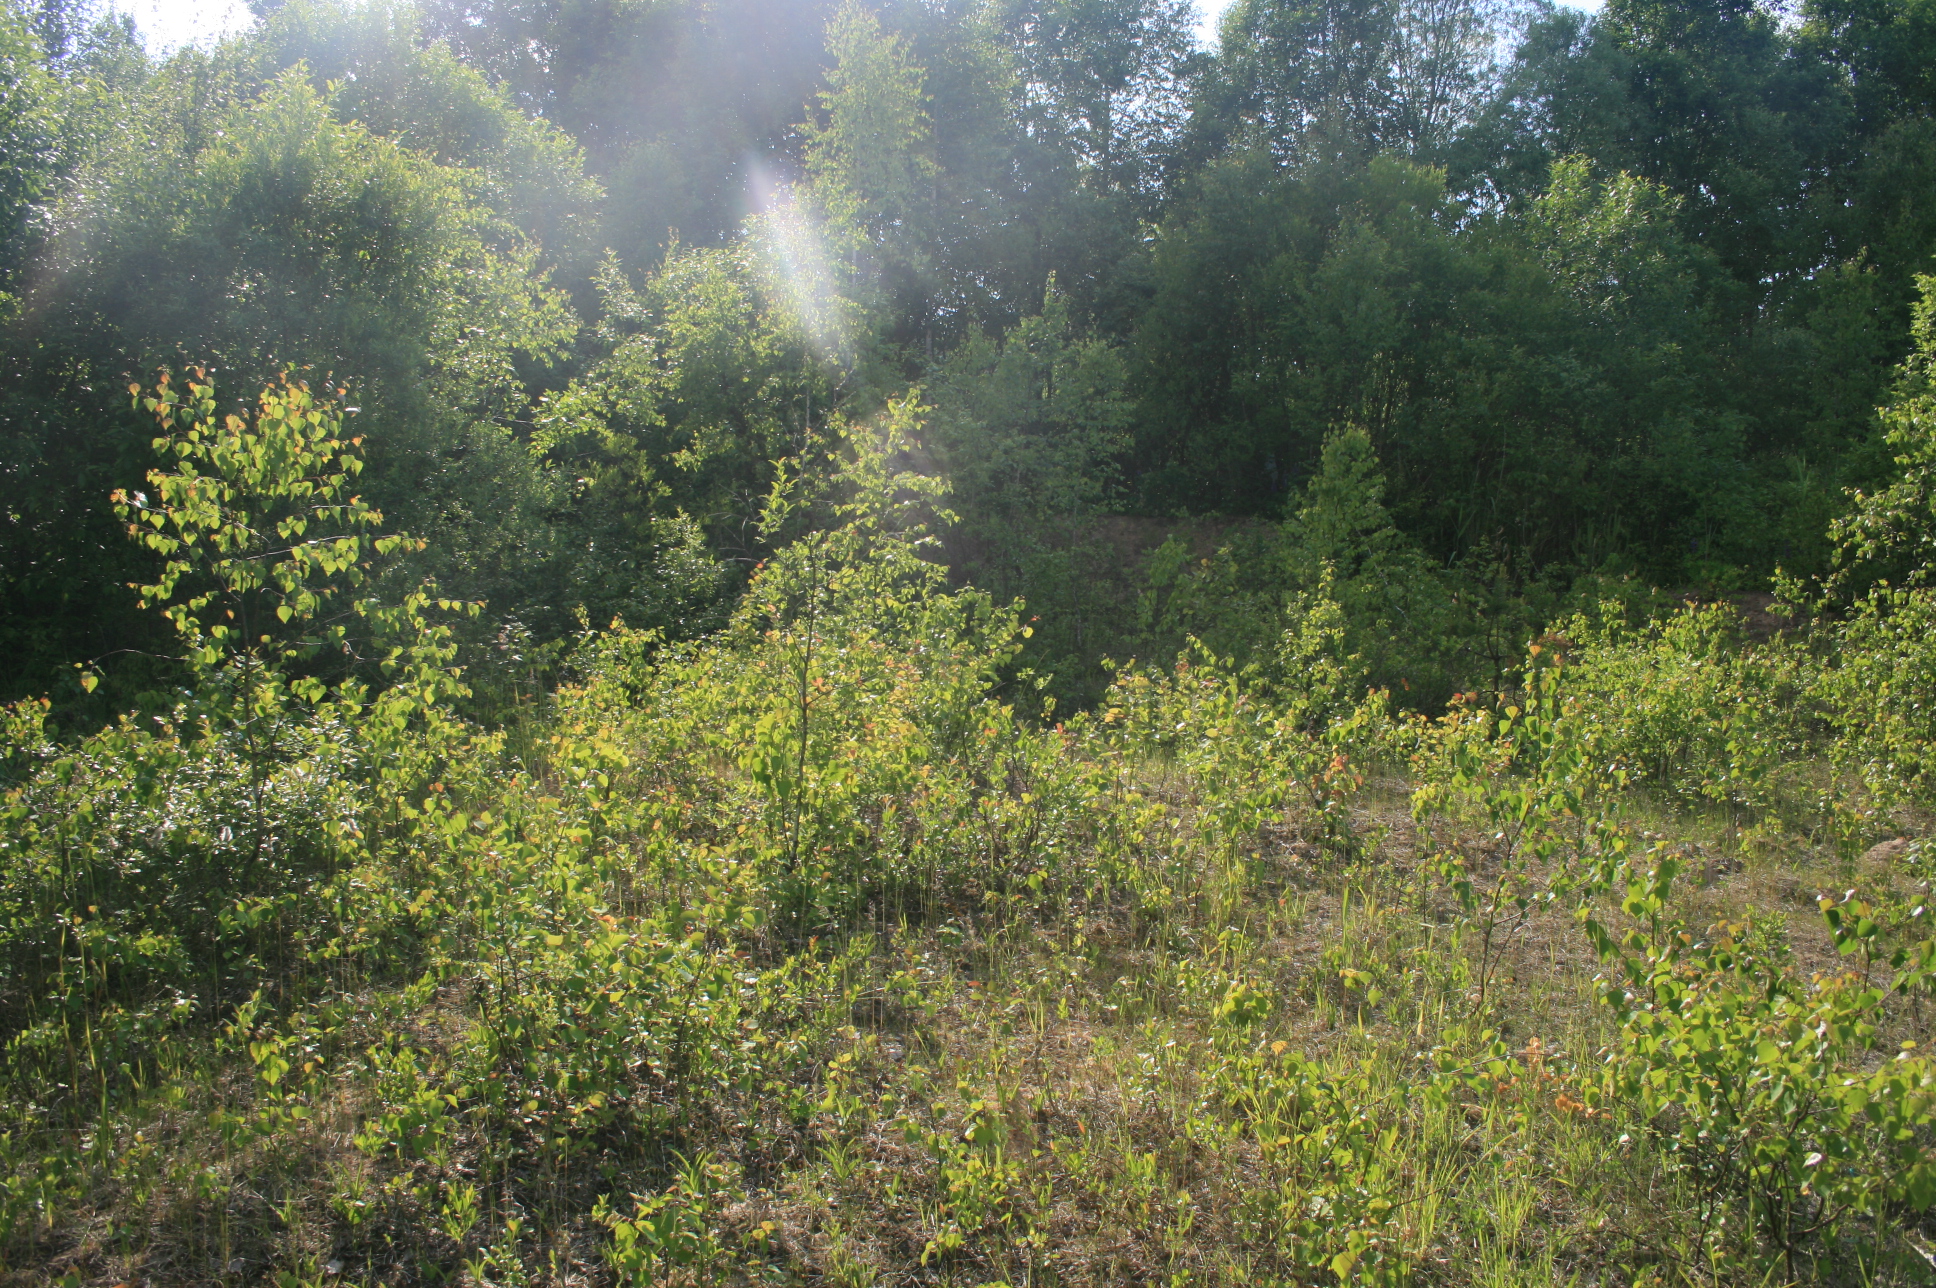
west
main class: Woodland
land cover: Broadleaved woodland
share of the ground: 50 - 75 %
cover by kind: broadleaved forest trees 60 %, herbaceous plants 25 %, unconsolidated bare surface 15 %
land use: Forestry
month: June
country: LT
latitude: 55.6385
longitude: 22.2091
